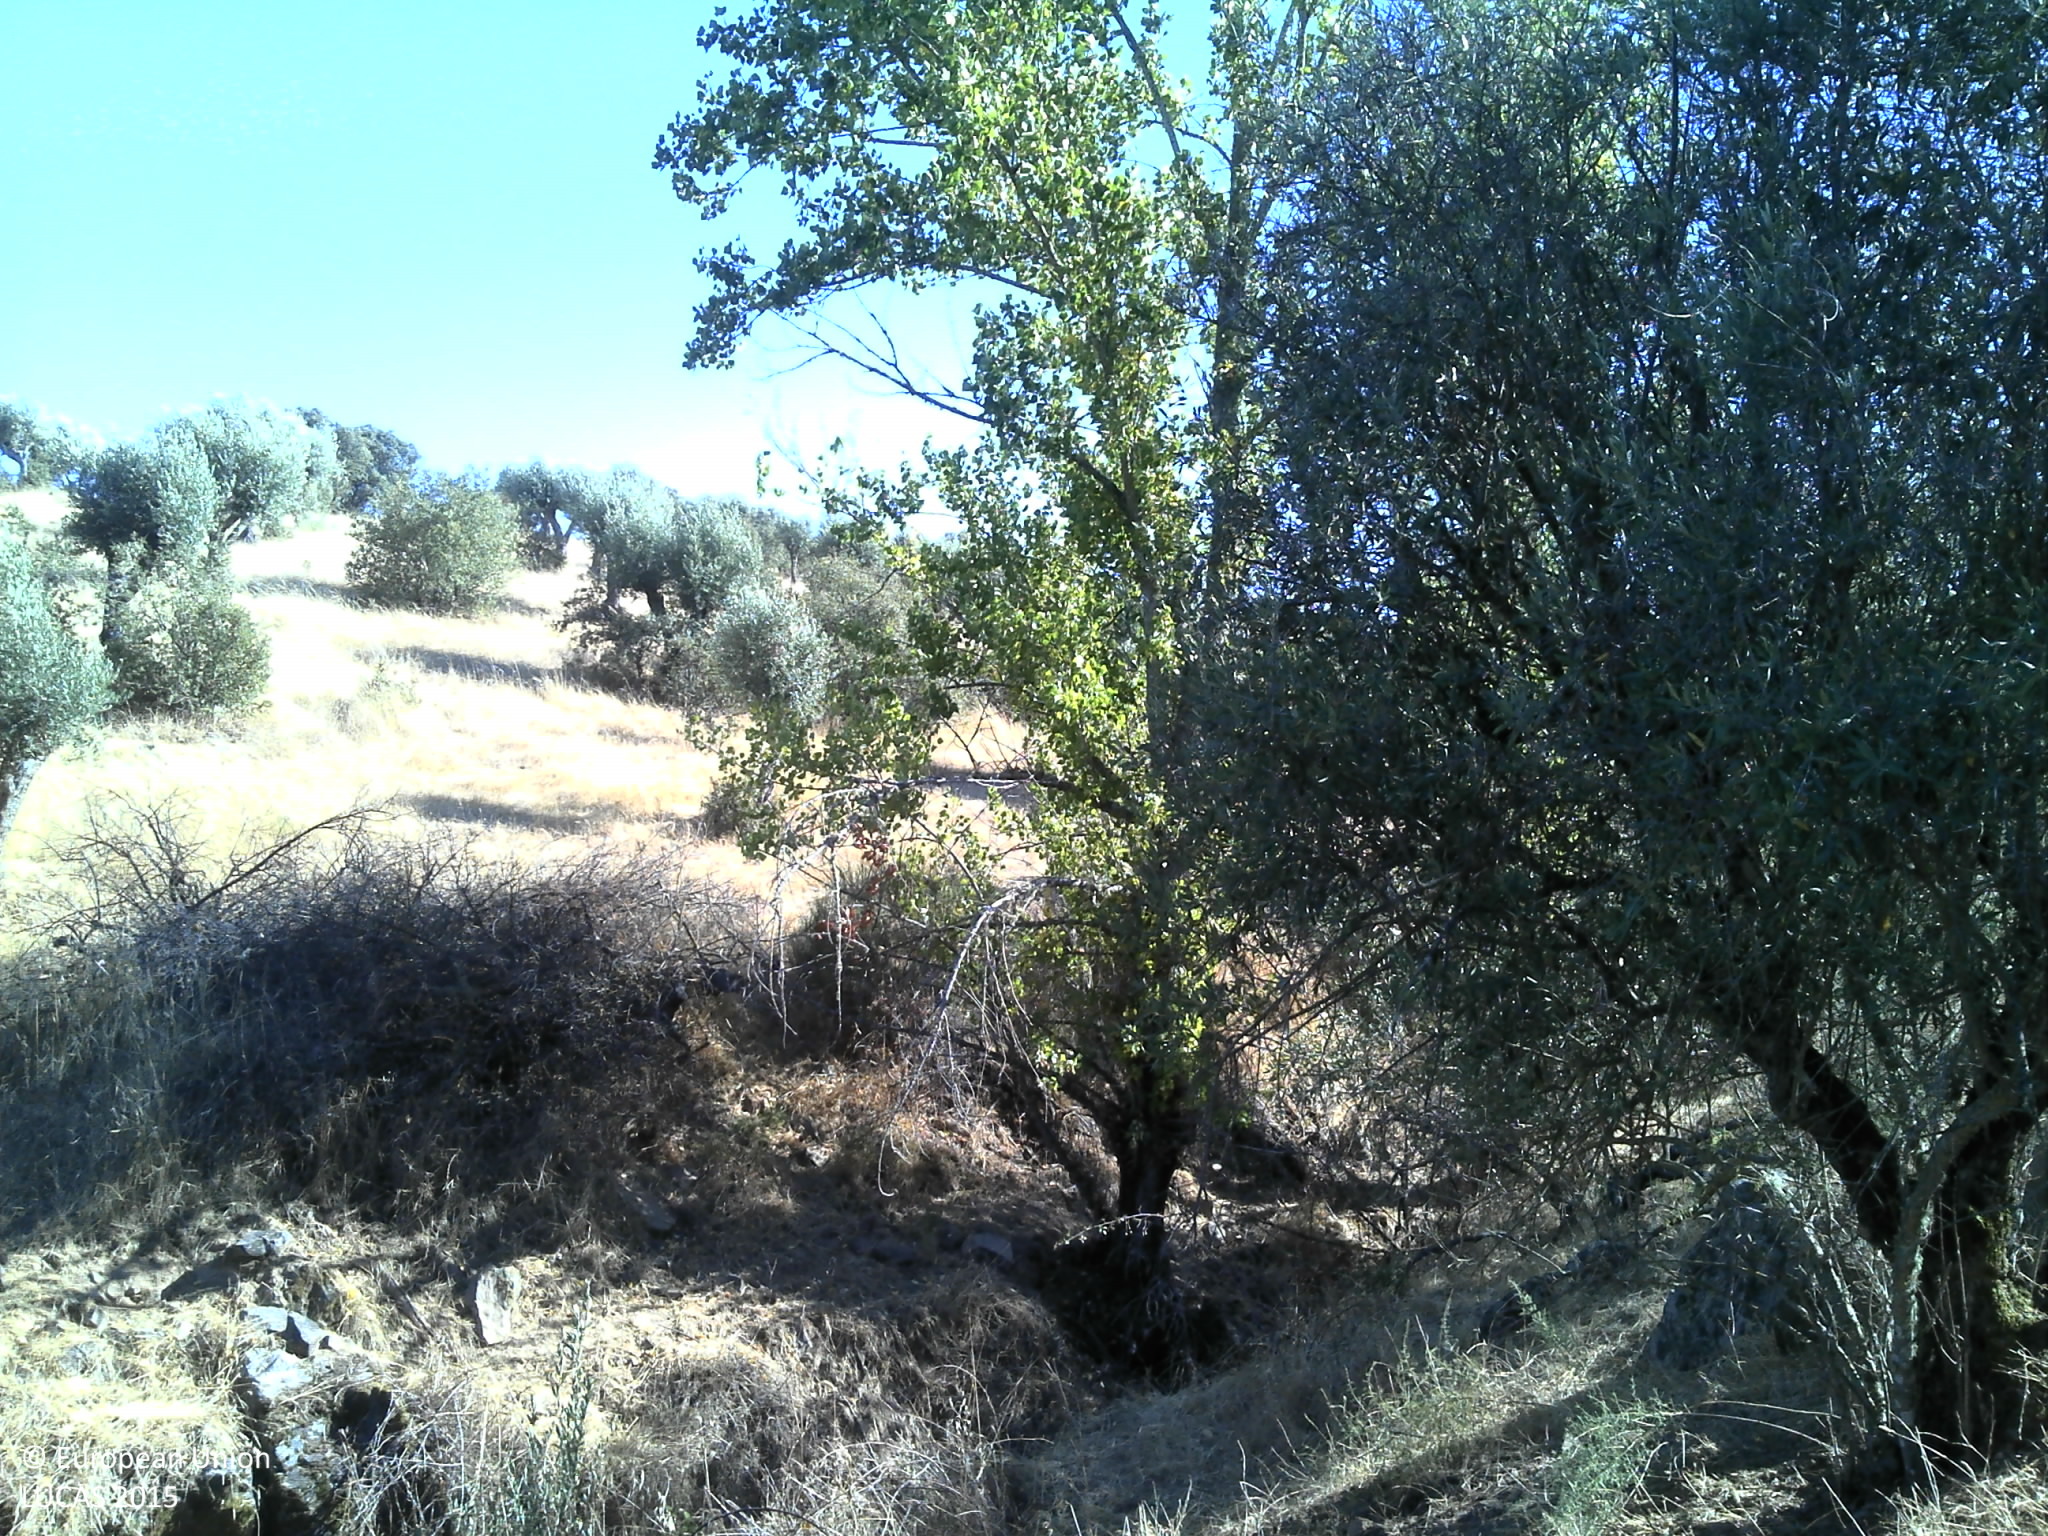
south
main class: Cropland
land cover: Olive groves
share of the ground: 25 - 50 %
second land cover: Grassland without tree/shrub cover
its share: 25 - 50 %
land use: Agriculture (excluding fallow land and kitchen gardens)
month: July
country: PT
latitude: 39.0419
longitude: -7.5431
